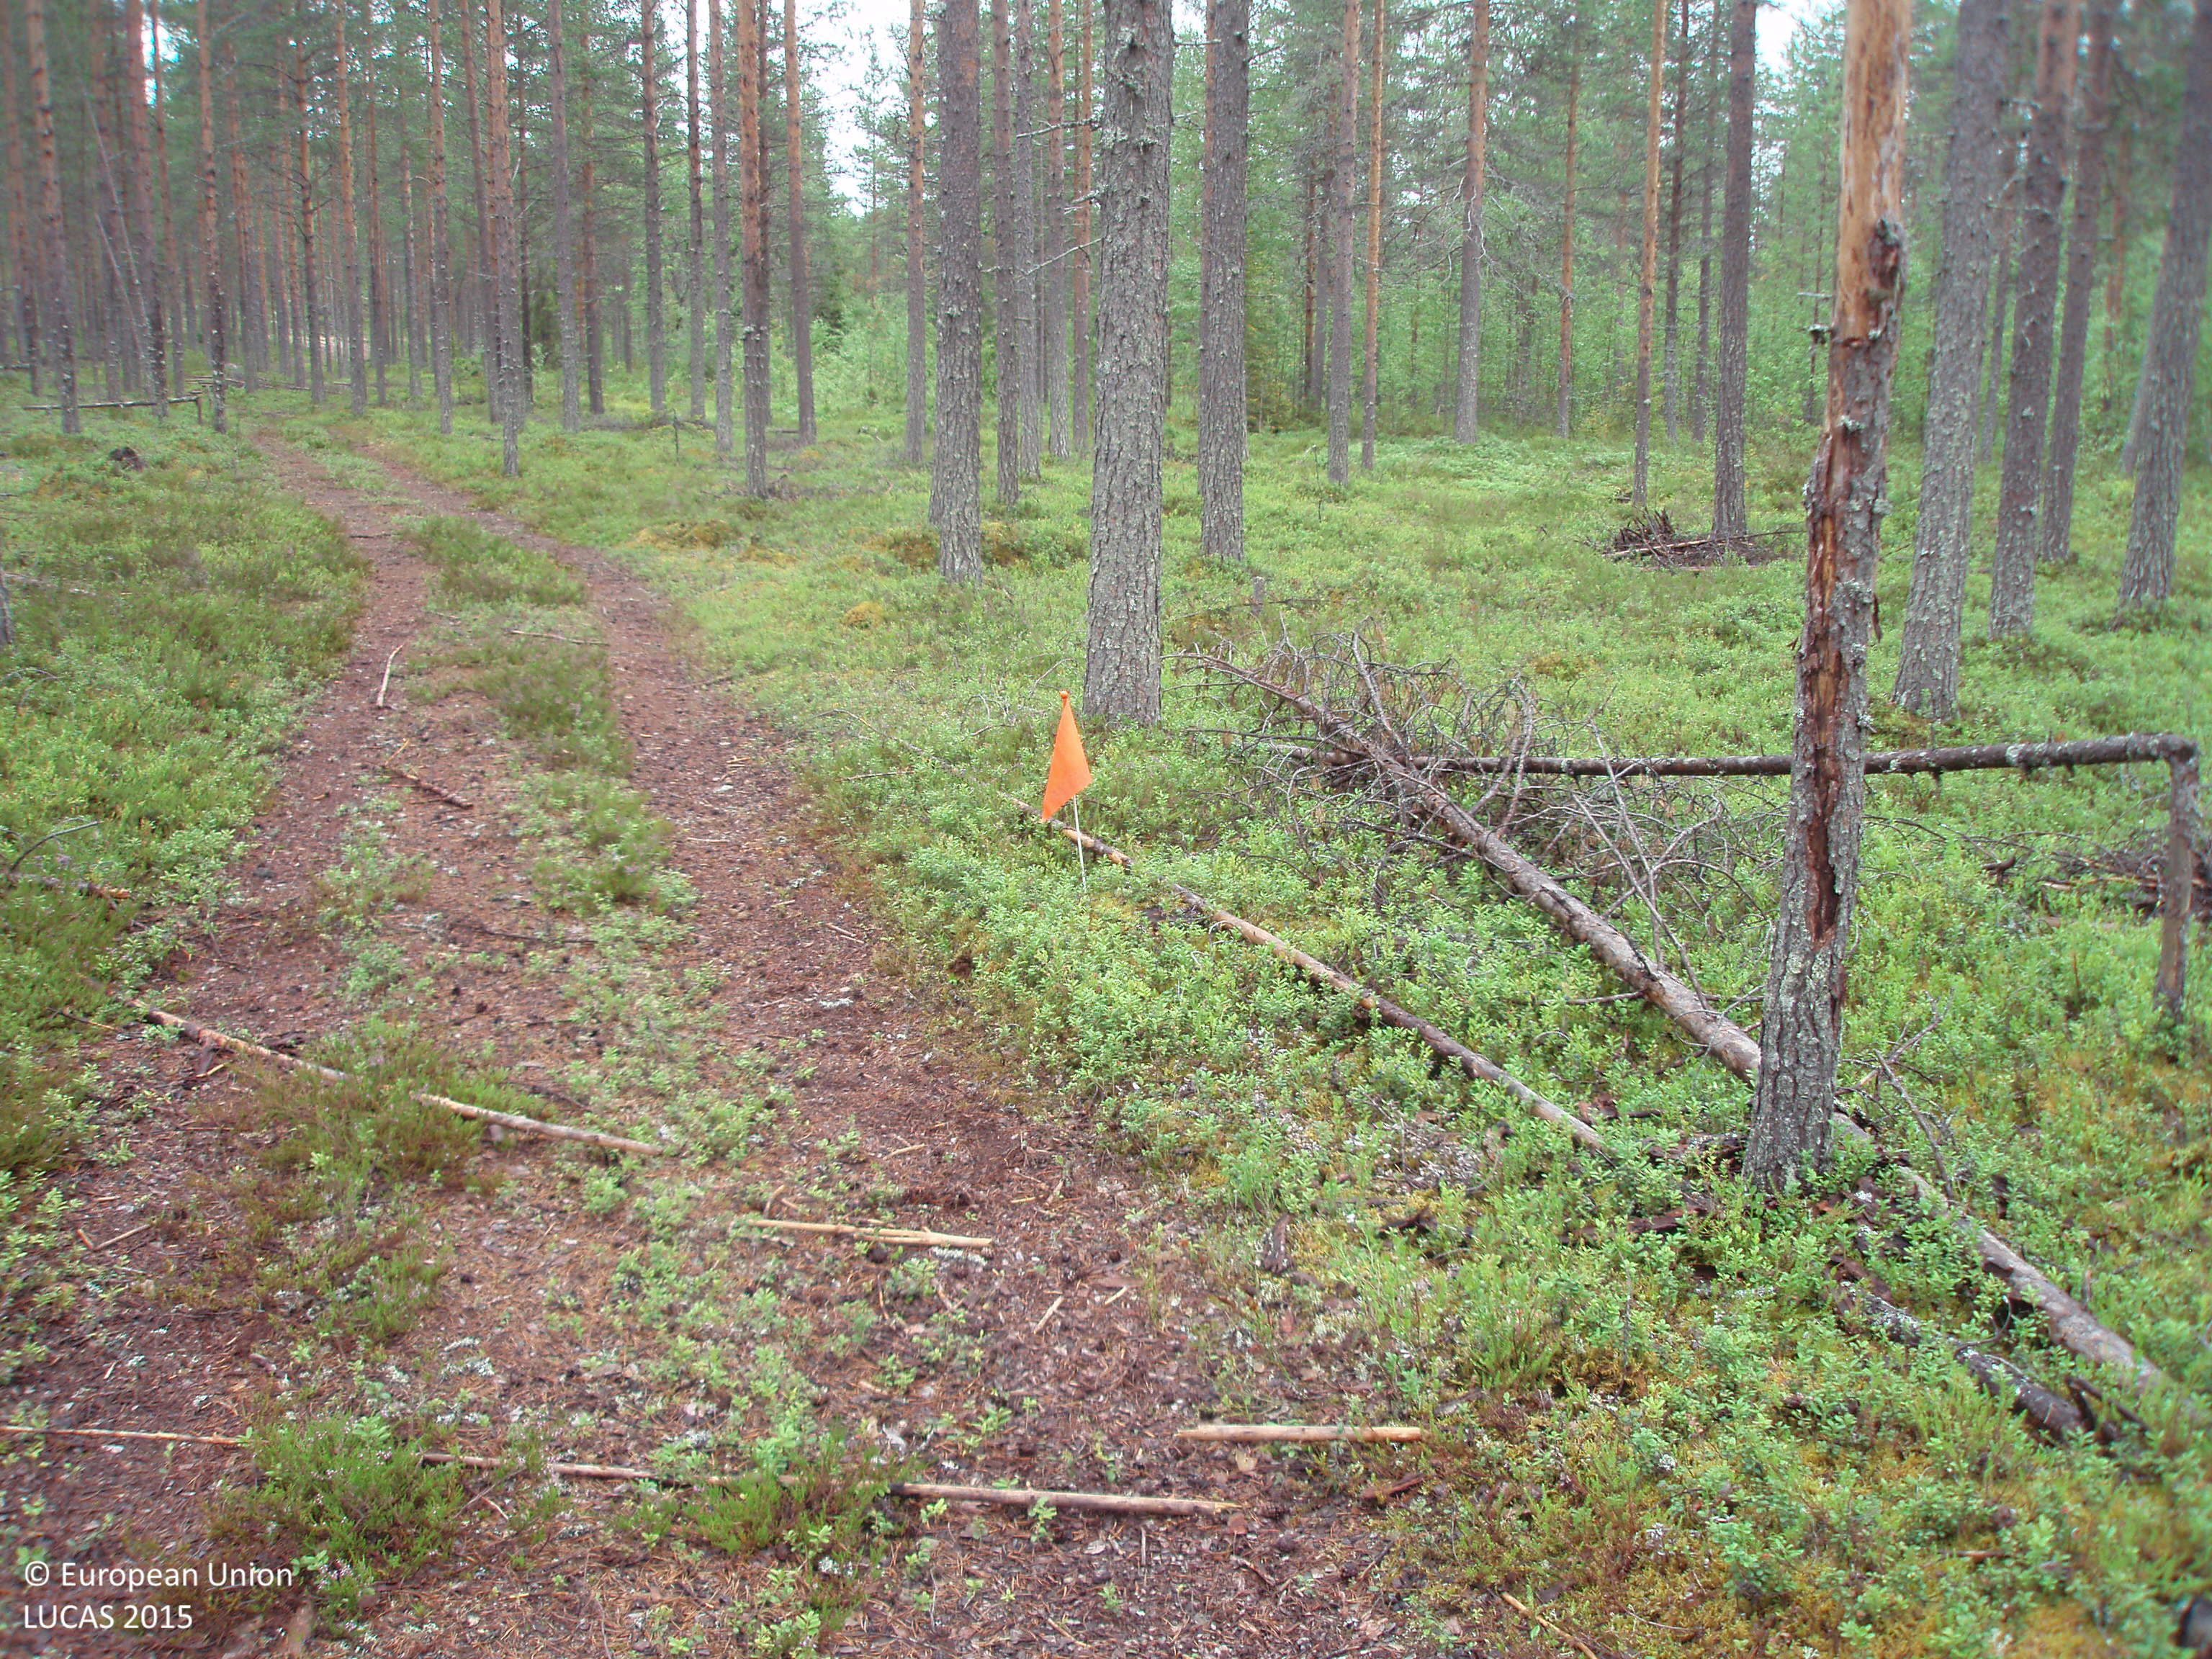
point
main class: Woodland
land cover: Pine dominated coniferous woodland
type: boreal forest
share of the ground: 50 - 75 %
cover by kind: coniferous forest trees 65 %, shrubs 35 %
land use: Forestry
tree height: > 5 m
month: August
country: FI
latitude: 65.6194
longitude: 27.0709
